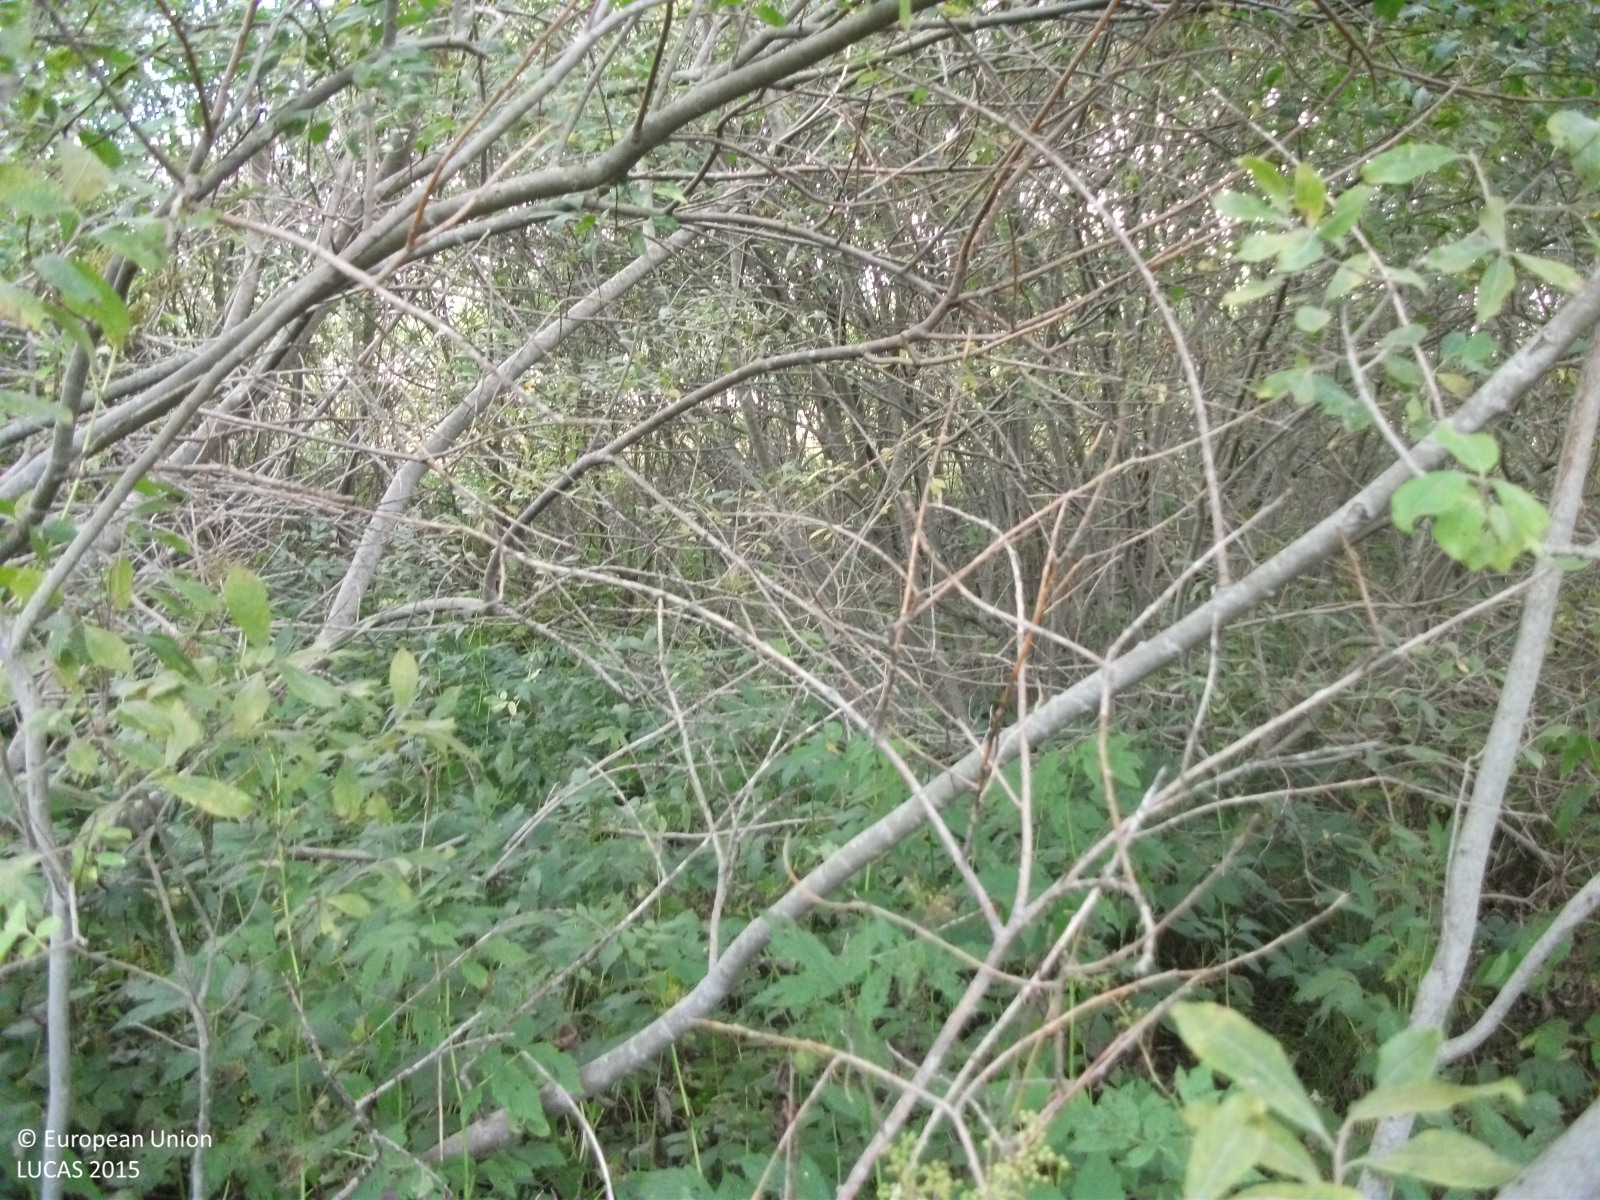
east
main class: Woodland
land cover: Broadleaved woodland
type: mire and swamp forests
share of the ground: 50 - 75 %
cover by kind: broadleaved forest trees 50 %, shrubs 45 %, herbaceous plants 5 %
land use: Semi-natural and natural areas not in use
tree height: > 5 m
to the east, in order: Broadleaved woodland; Spontaneously vegetated surfaces; Broadleaved woodland; Ditches and canals; Broadleaved woodland; Spontaneously vegetated surfaces; Grassland without tree/shrub cover; Artificial constructions in urban areas; Grassland without tree/shrub cover; Apple fruit; Fences; Broadleaved woodland
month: September
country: LV
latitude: 57.4625
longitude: 24.5111
